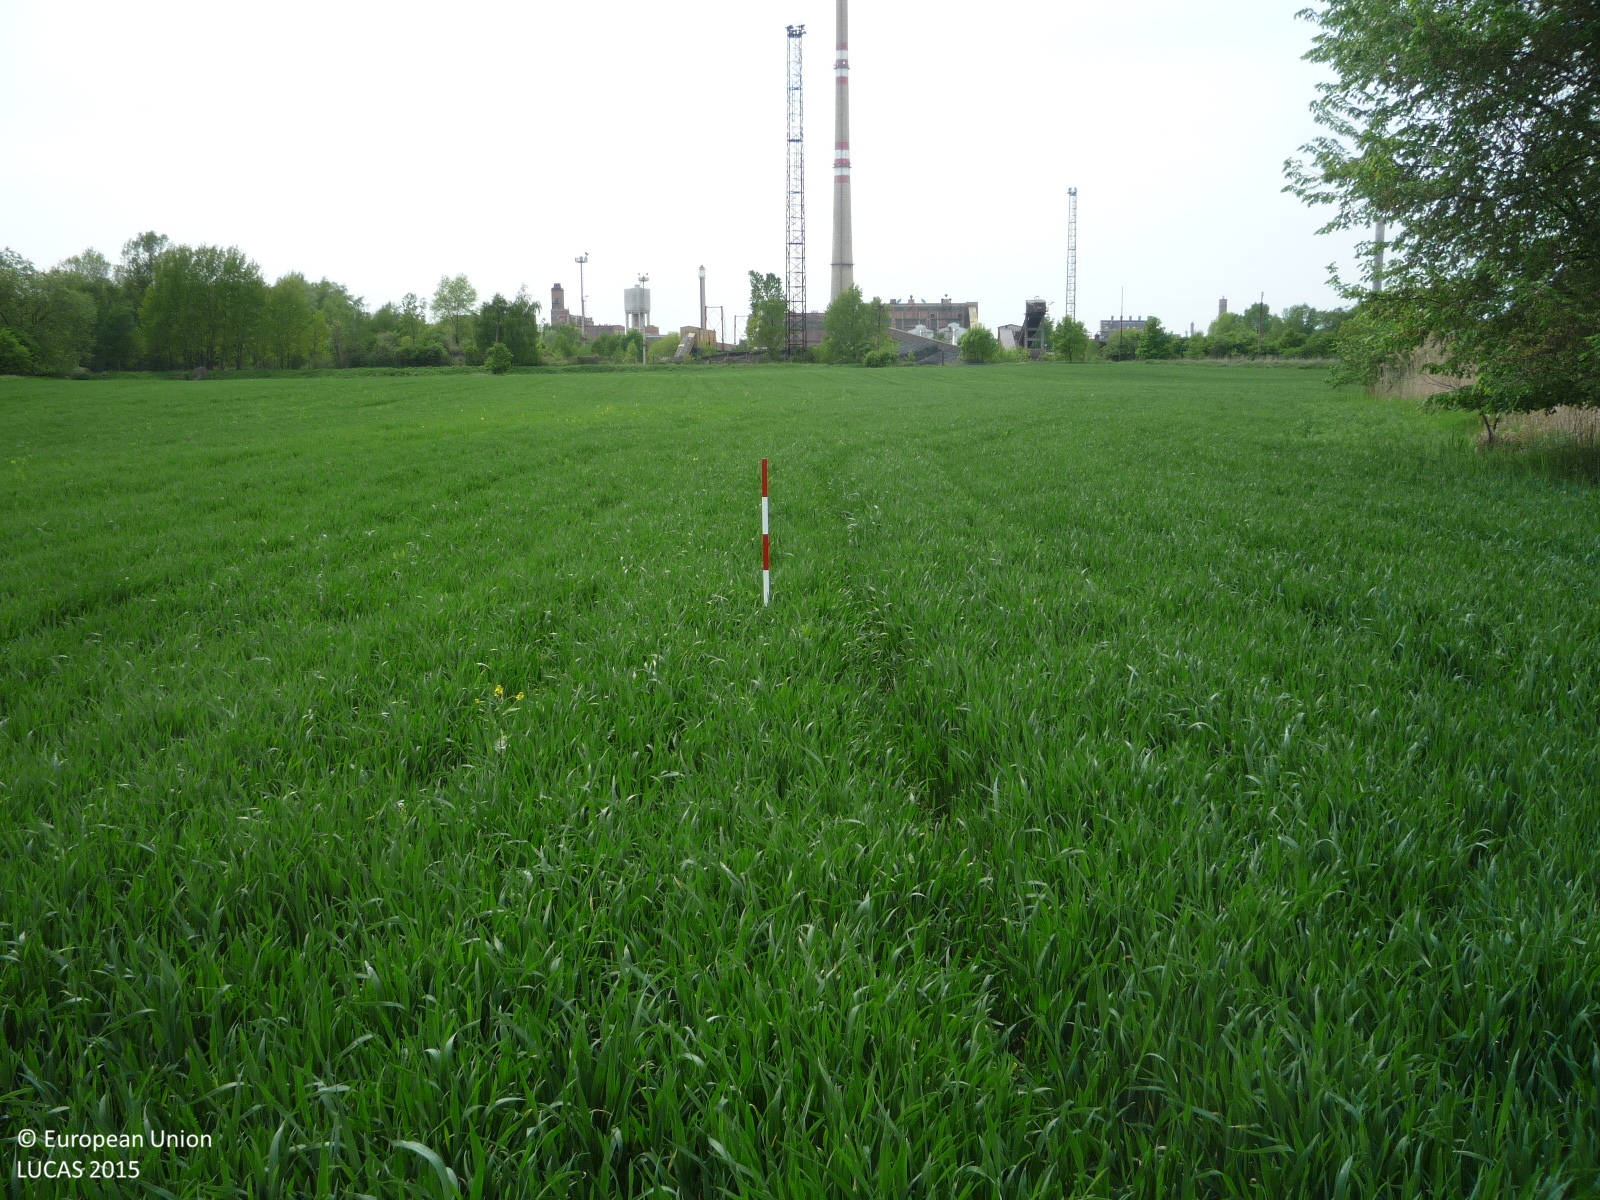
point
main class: Cropland
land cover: Common wheat
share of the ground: > 75 %
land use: Agriculture (excluding fallow land and kitchen gardens)
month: May
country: CZ
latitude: 50.2742
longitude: 14.5339
